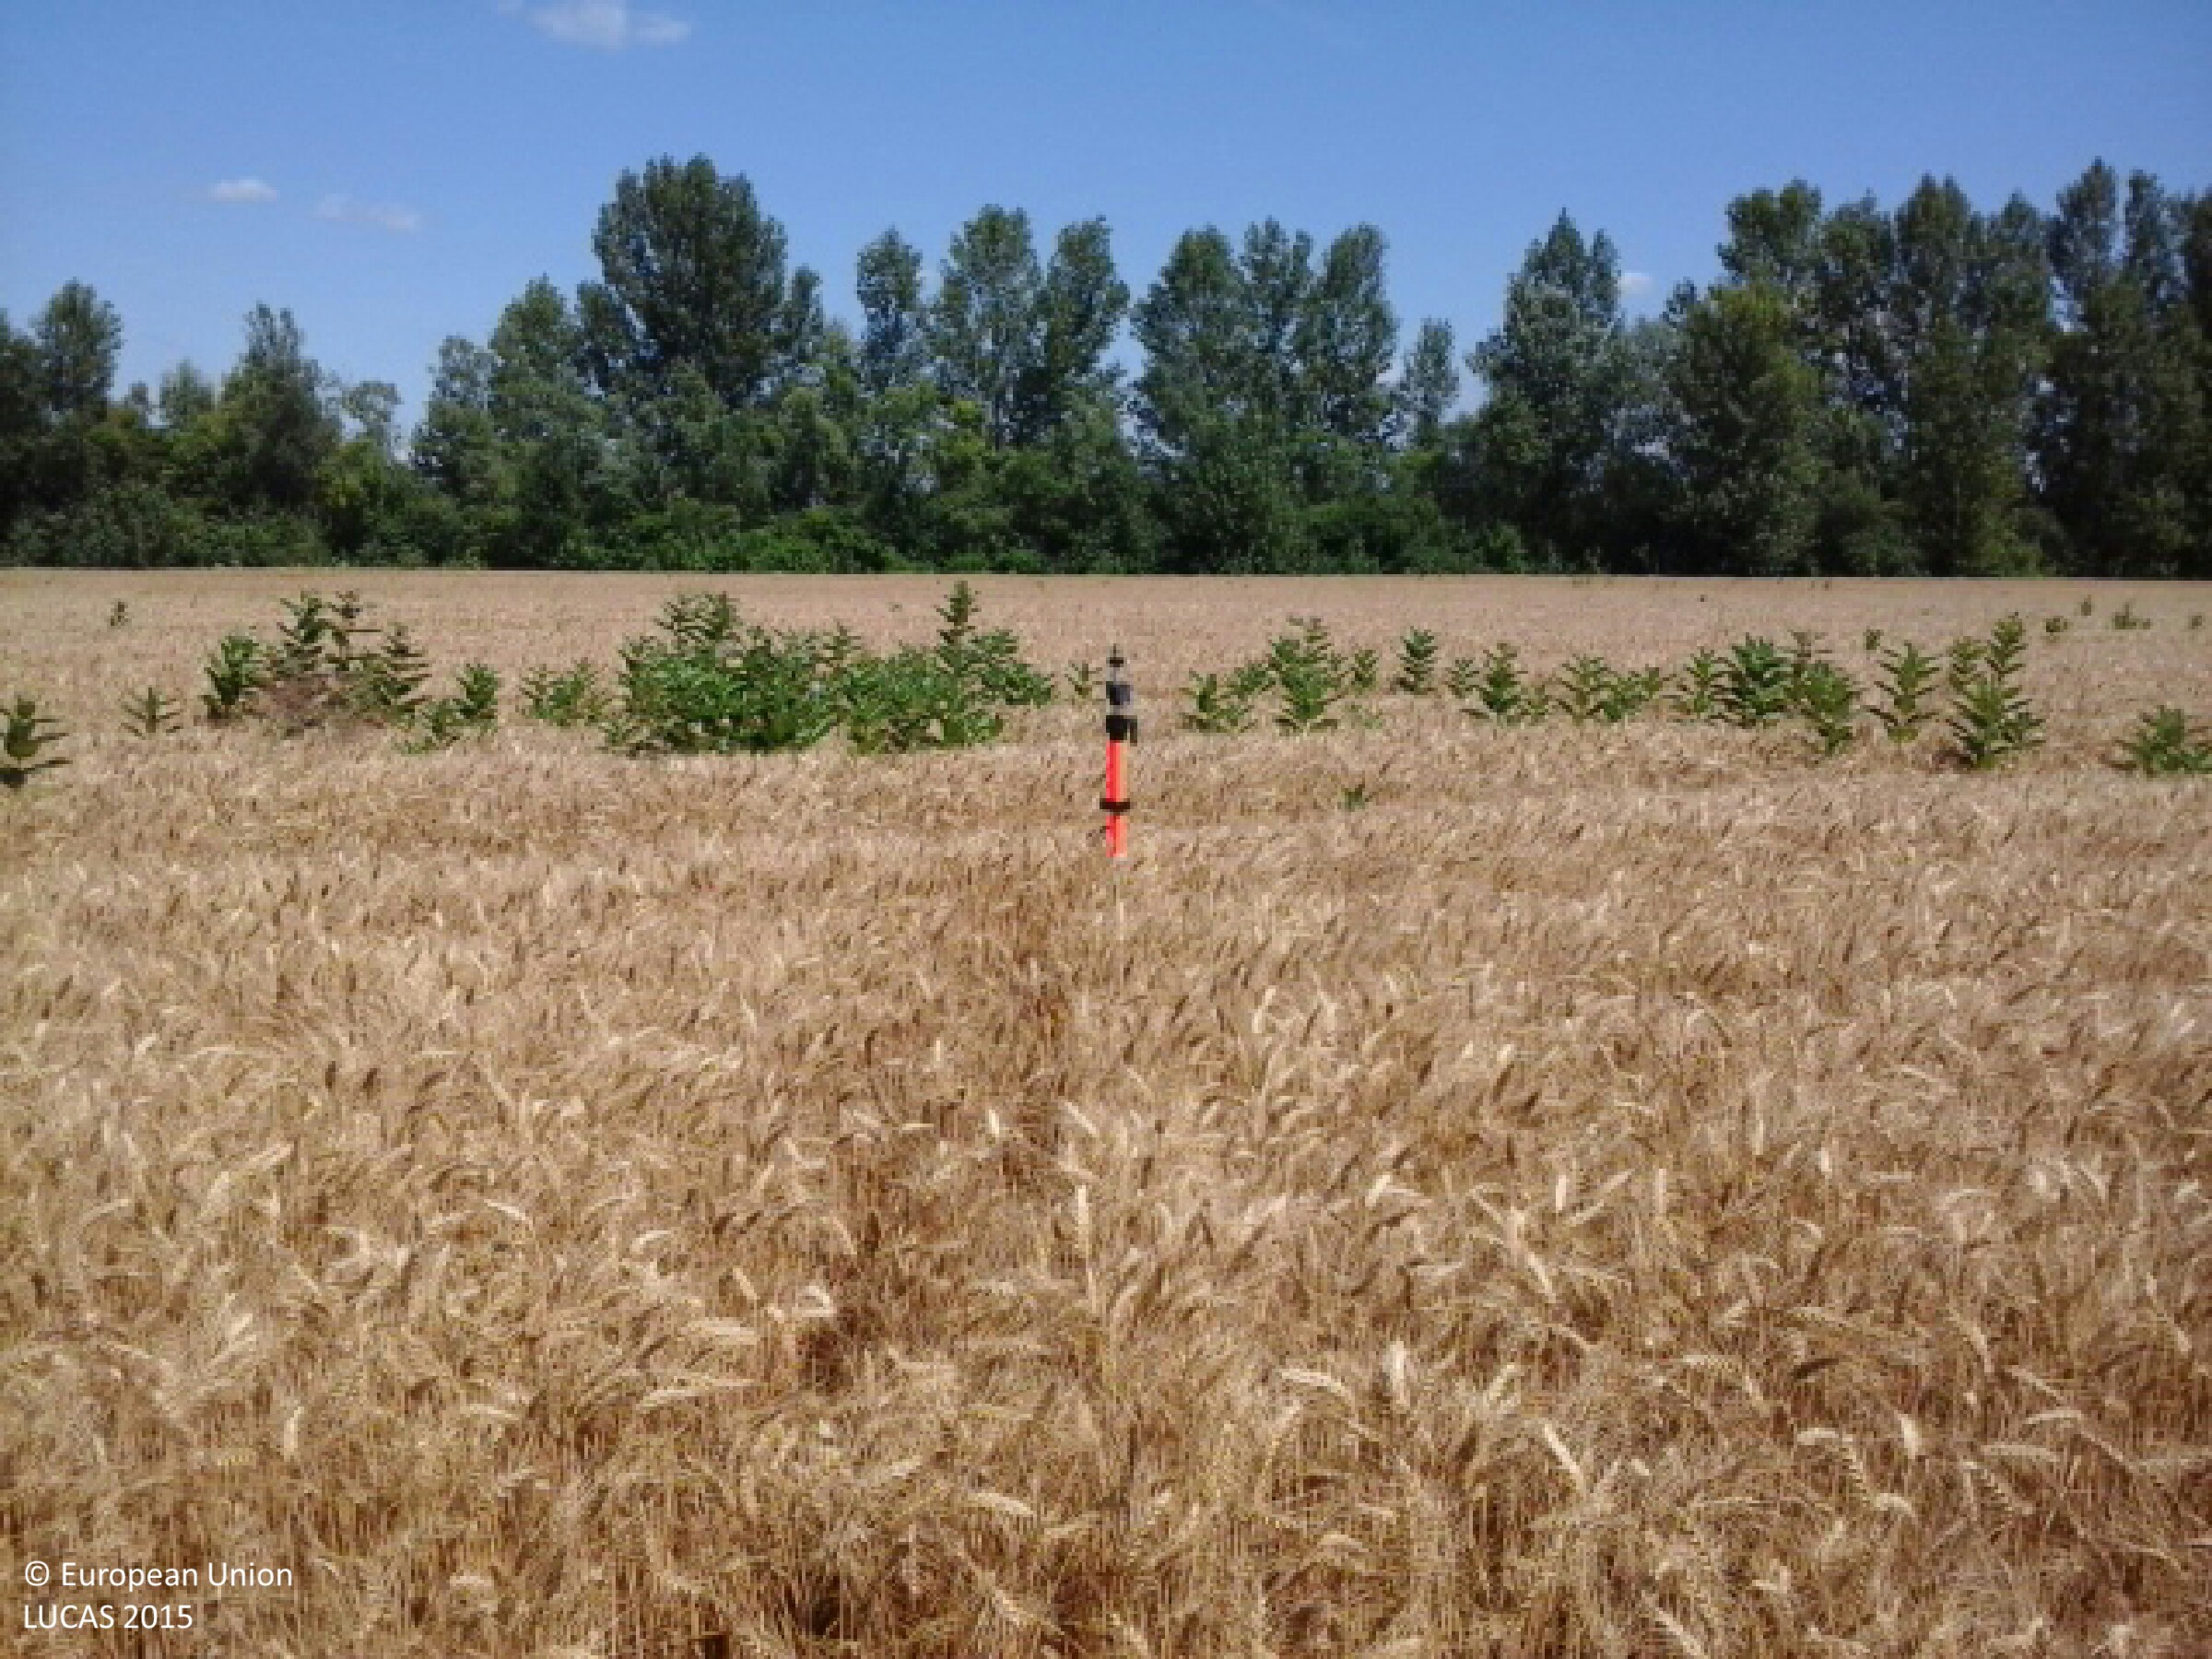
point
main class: Cropland
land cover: Durum wheat
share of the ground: > 75 %
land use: Agriculture (excluding fallow land and kitchen gardens)
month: July
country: HU
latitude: 47.9257
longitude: 22.3563
